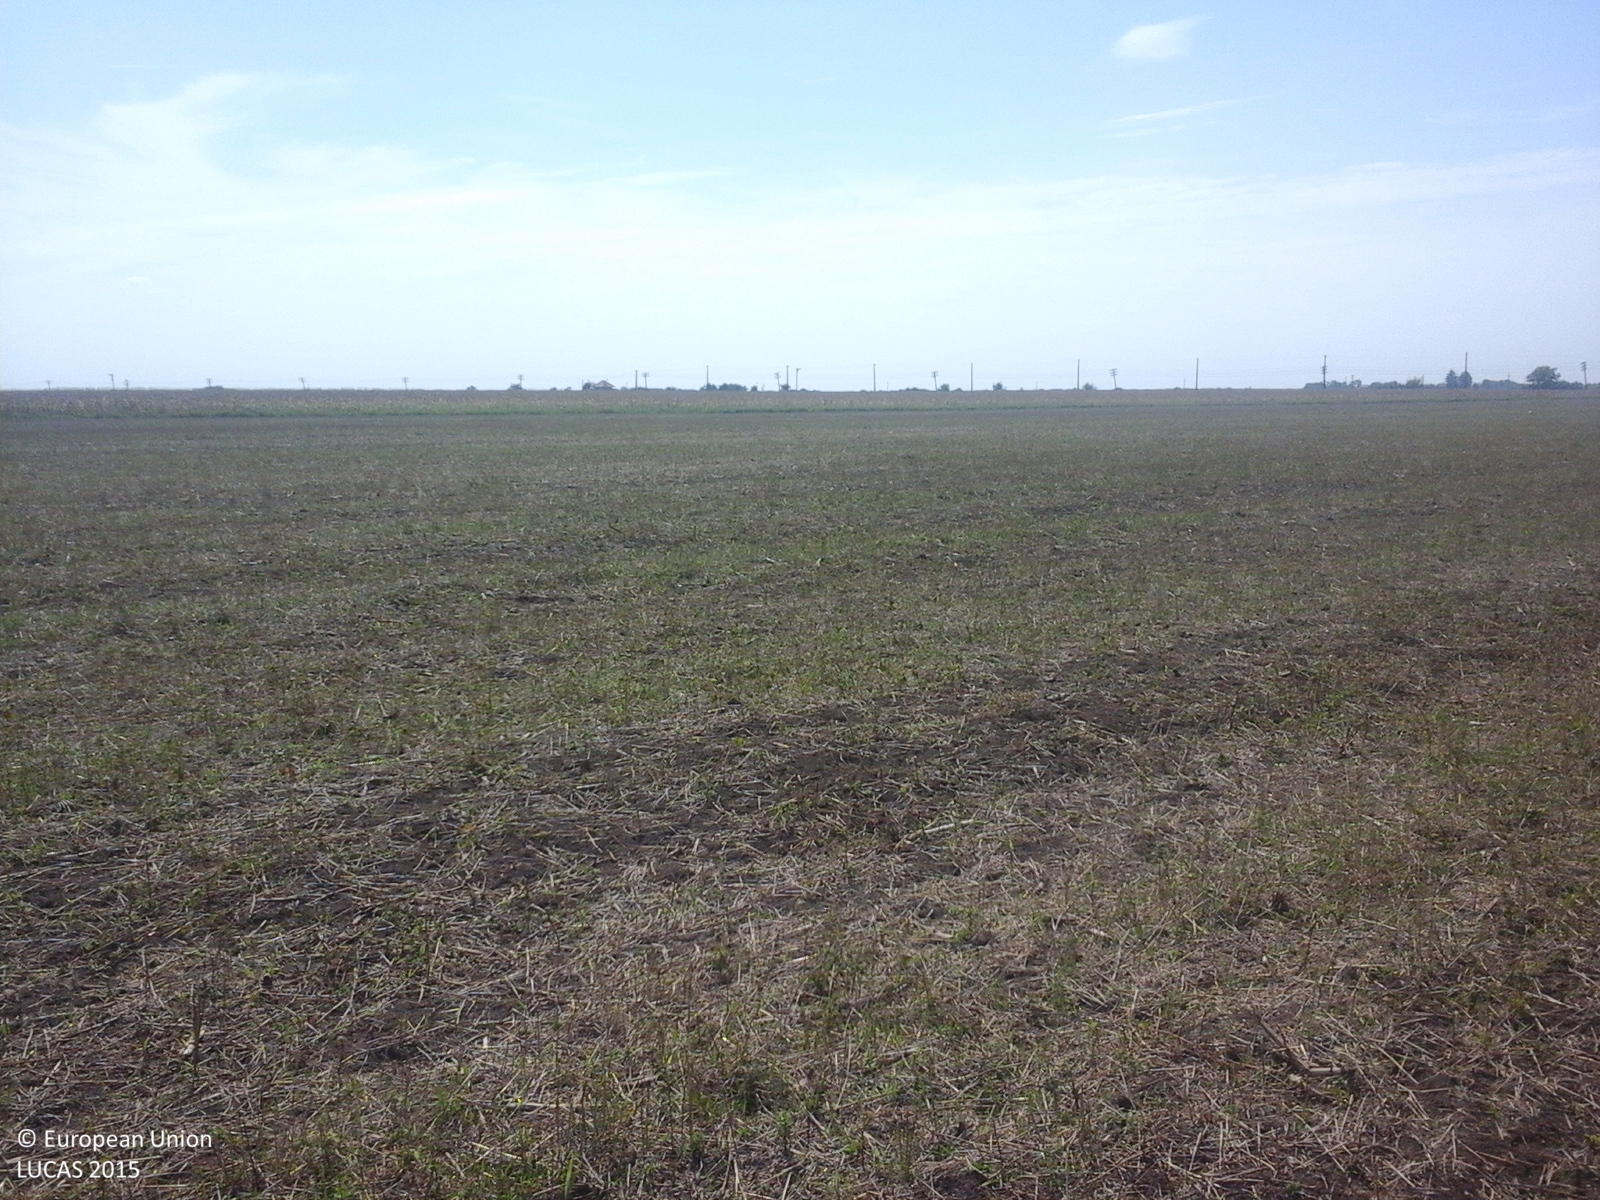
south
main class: Cropland
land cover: Durum wheat
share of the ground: 10 - 25 %
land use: Agriculture (excluding fallow land and kitchen gardens)
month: August
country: RO
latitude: 46.4225
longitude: 21.4744
